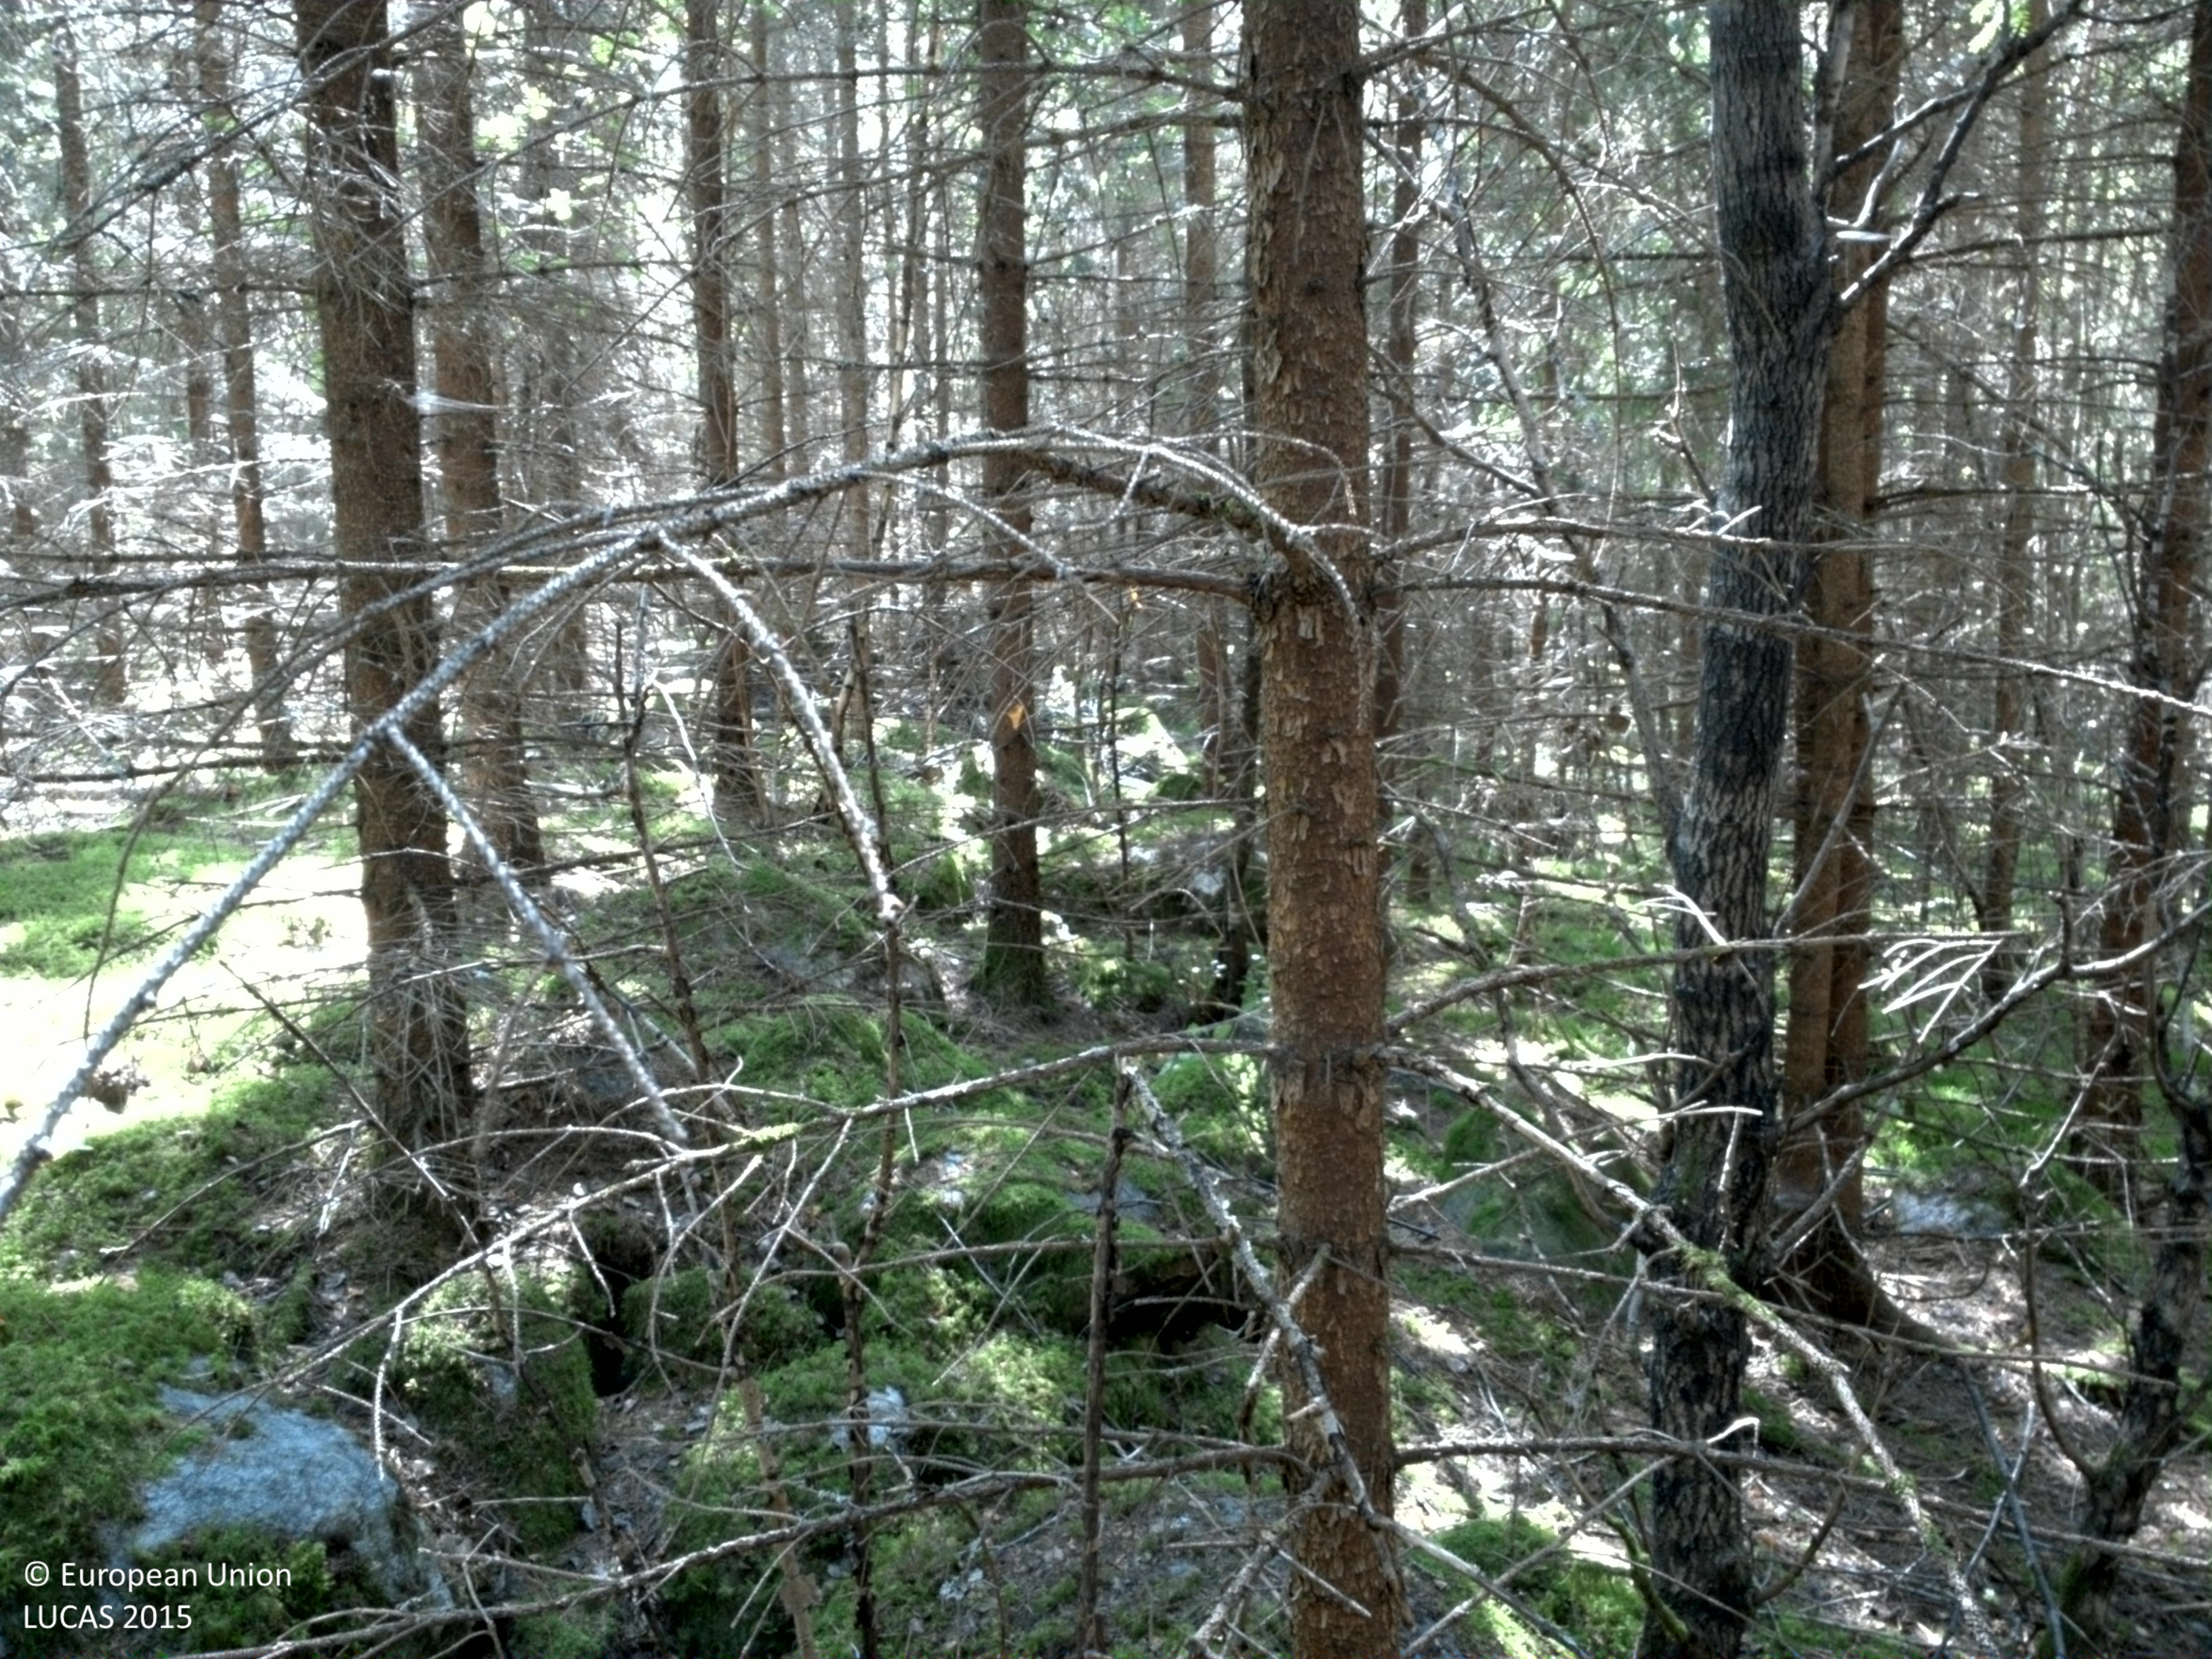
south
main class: Woodland
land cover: Spruce dominated coniferous woodland
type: boreal forest
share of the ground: > 75 %
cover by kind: coniferous forest trees 95 %, lichens and mosses 5 %
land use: Forestry
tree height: > 5 m
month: August
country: SE
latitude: 59.7013
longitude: 17.6541
